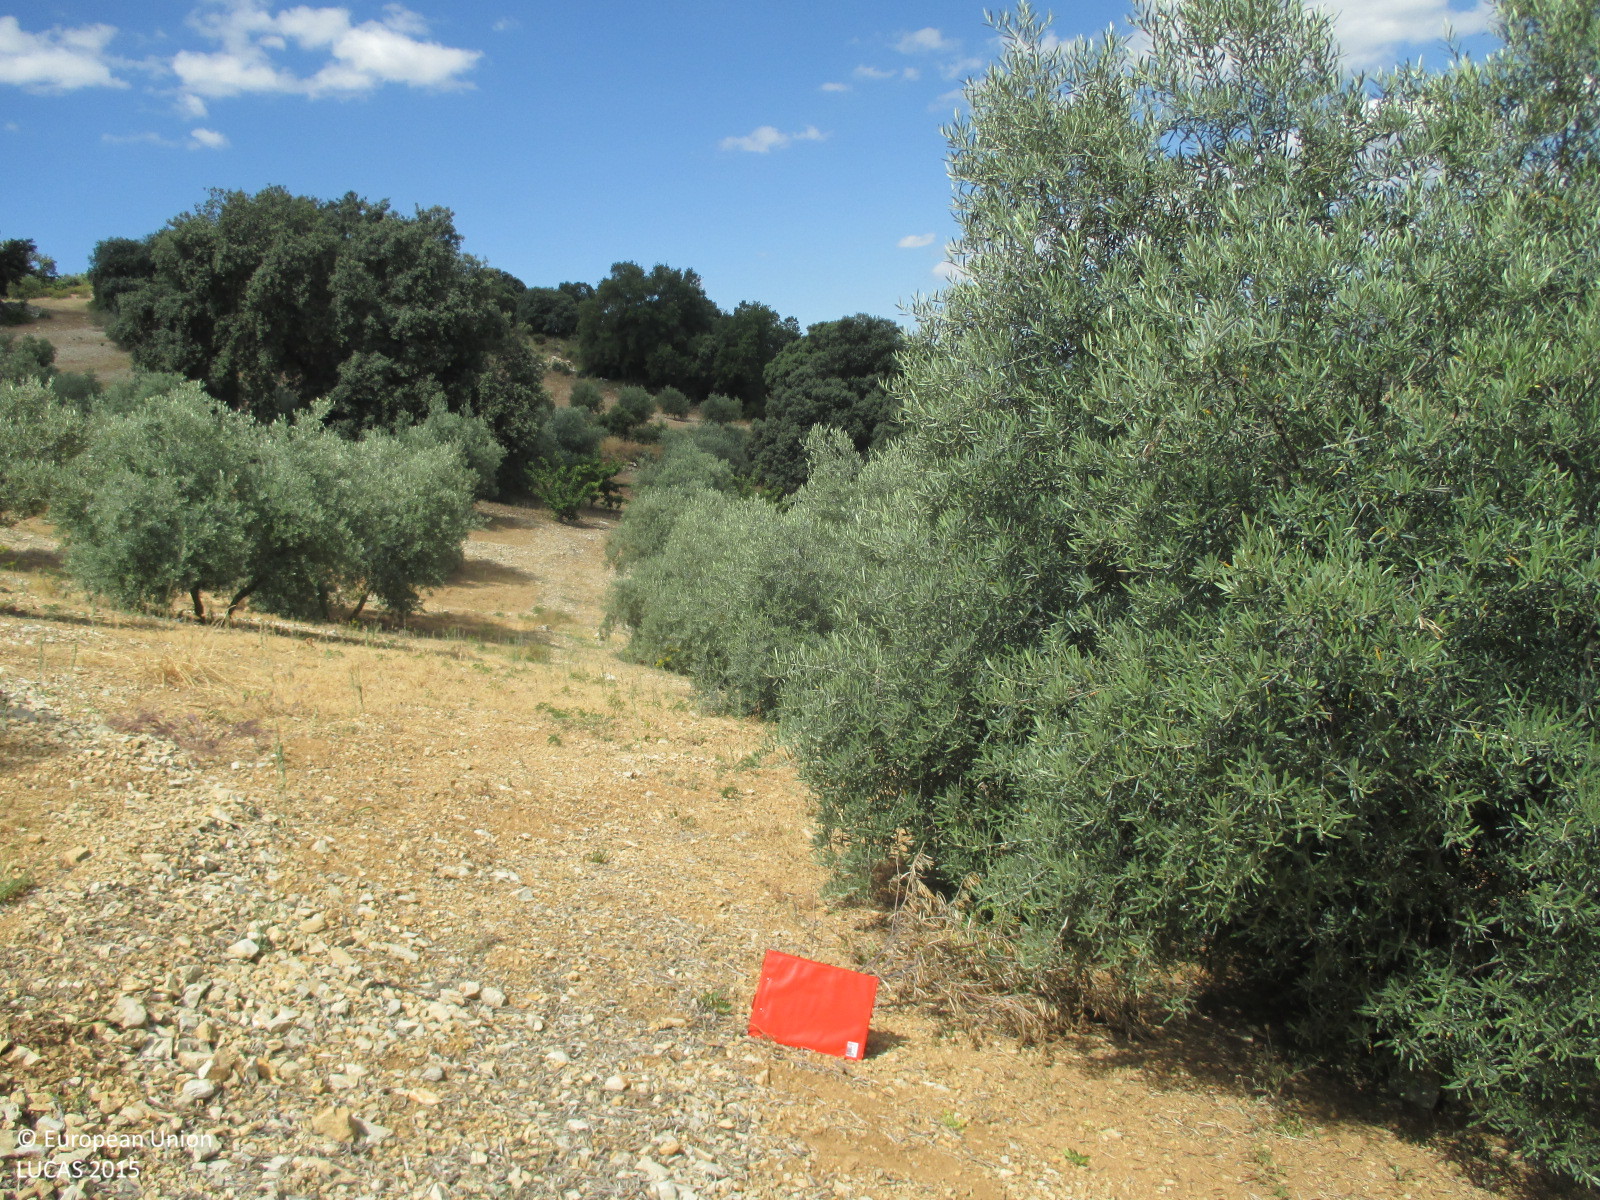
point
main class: Cropland
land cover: Olive groves
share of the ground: 10 - 25 %
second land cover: Other bare soil
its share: > 75 %
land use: Agriculture (excluding fallow land and kitchen gardens)
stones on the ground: < 10 %
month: June
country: ES
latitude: 37.3565
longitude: -4.0756
